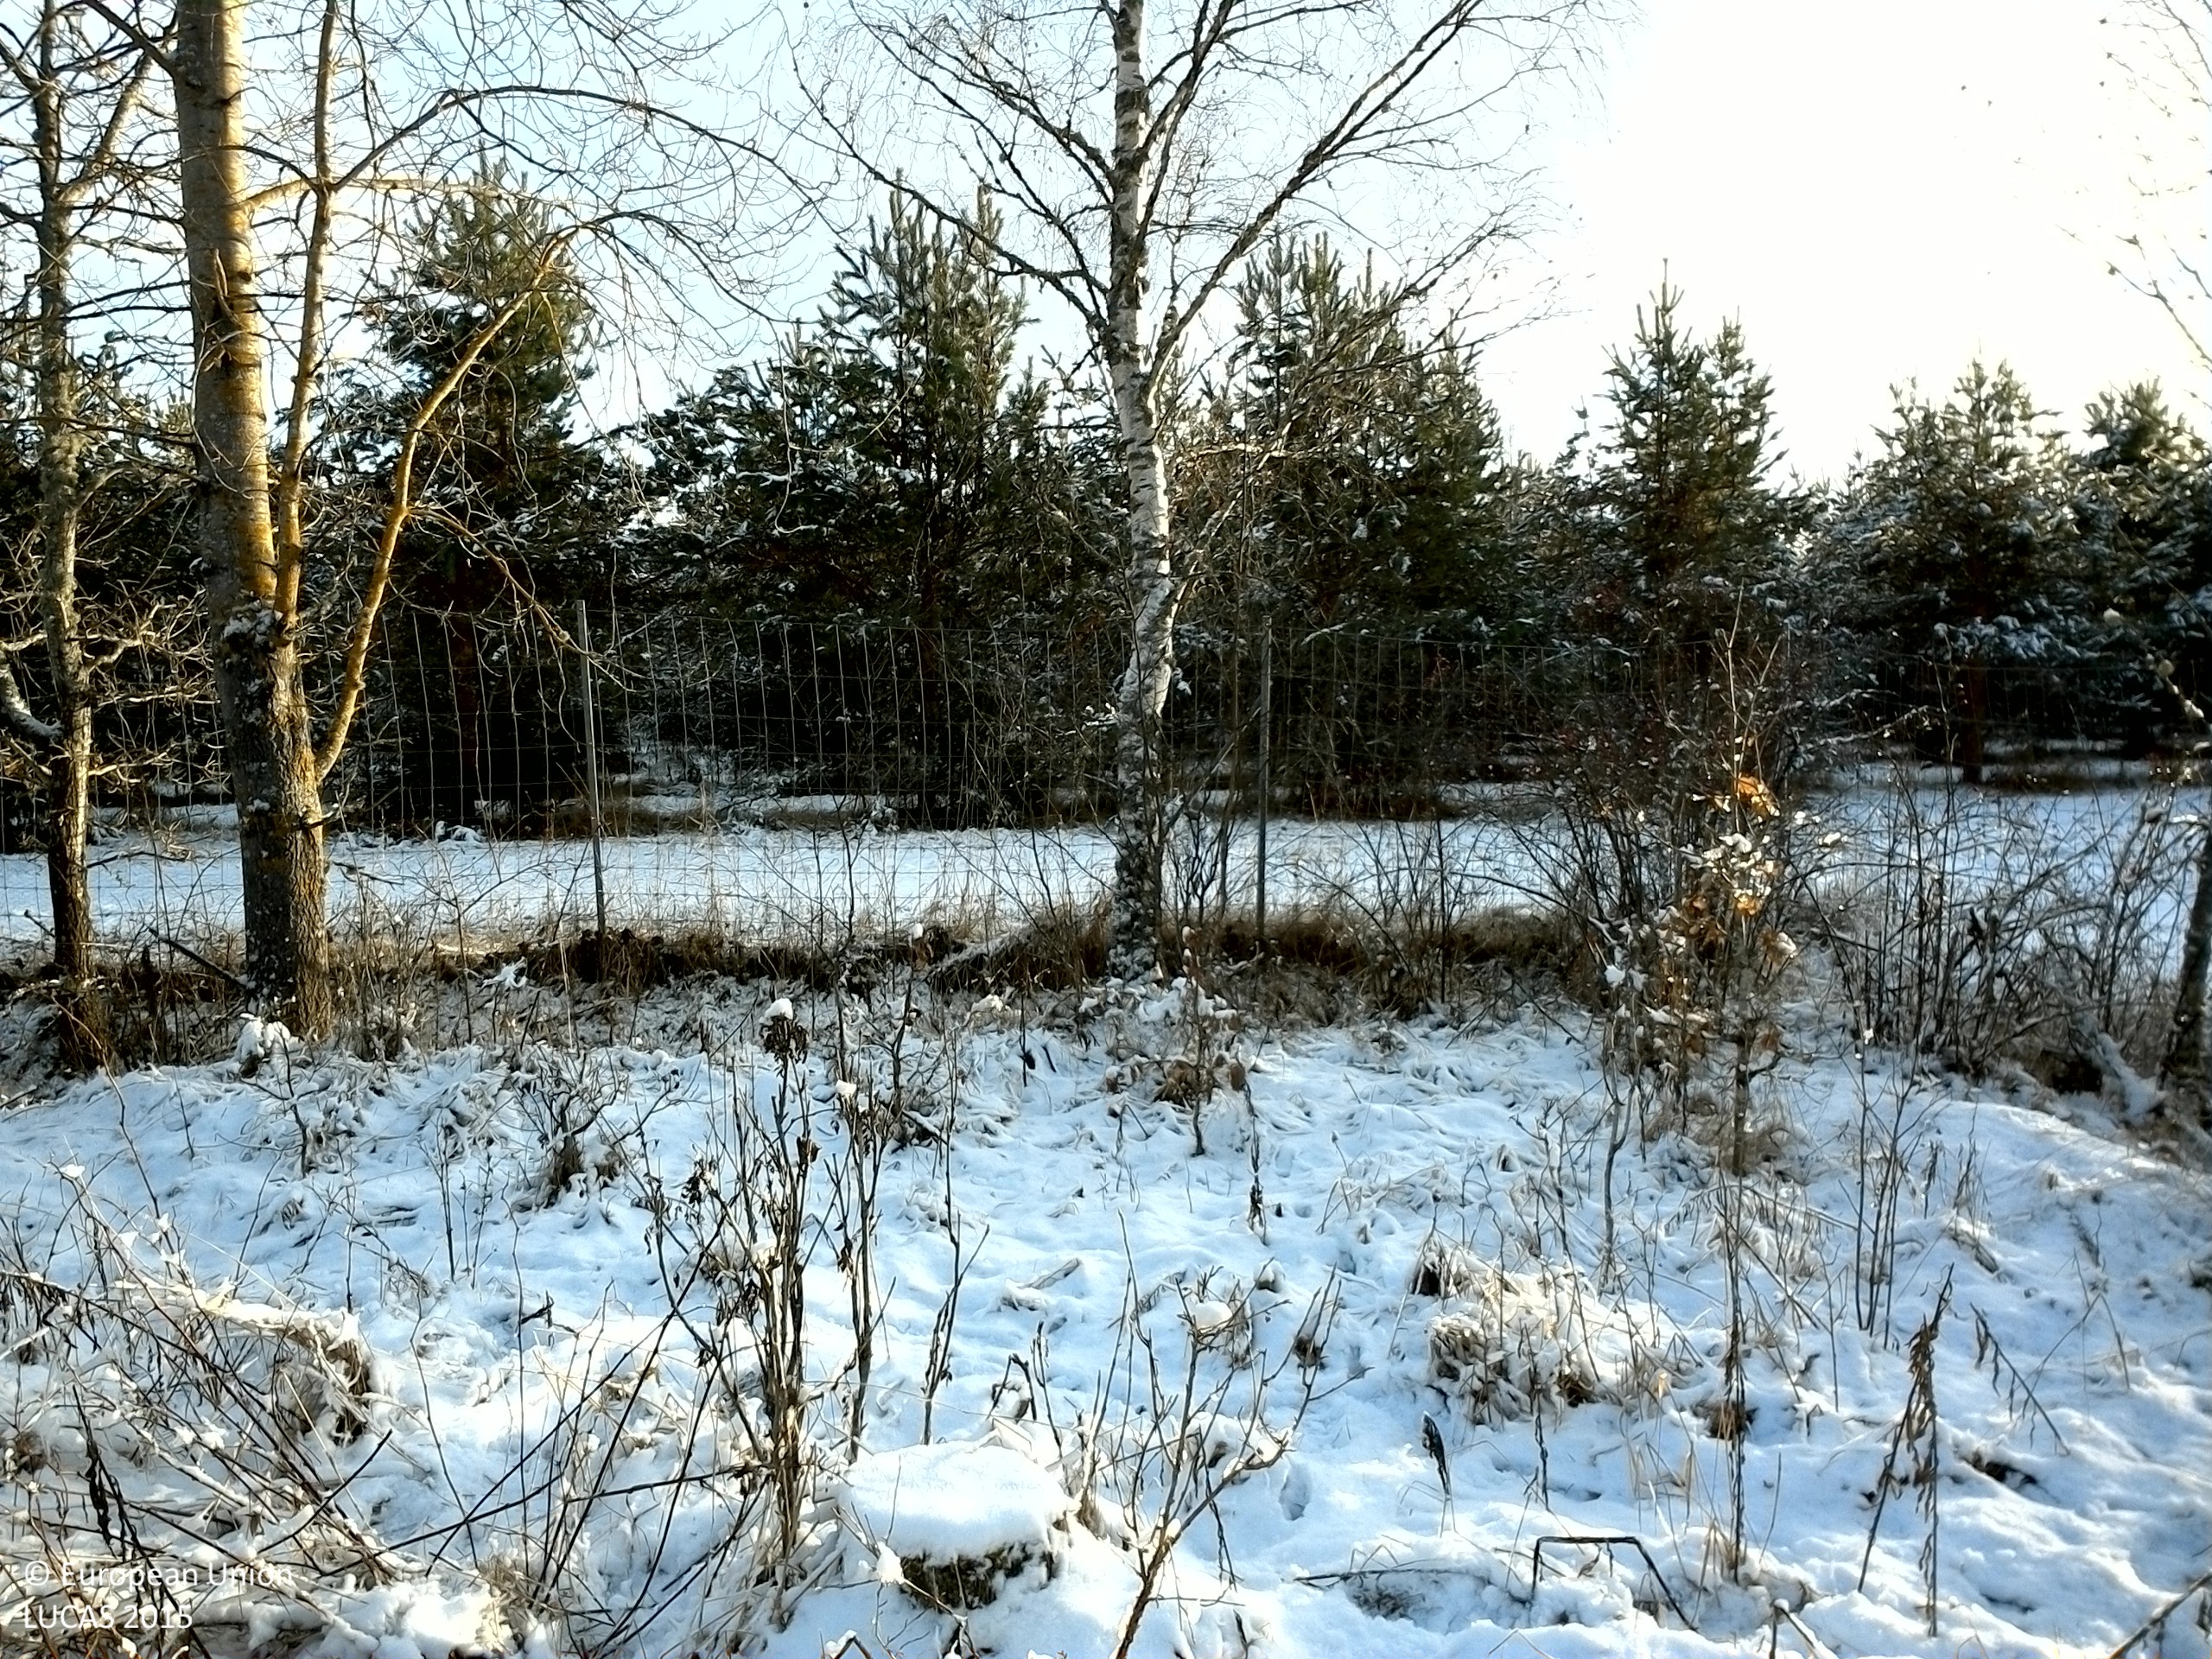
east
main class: Woodland
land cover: Spruce dominated mixed woodland
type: boreal forest
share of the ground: 50 - 75 %
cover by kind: broadleaved forest trees 40 %, shrubs 30 %, coniferous forest trees 20 %, herbaceous plants 10 %
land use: Forestry
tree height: > 5 m
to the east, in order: Spruce dominated mixed woodland; Single bushes/trees; Ditches and canals; Fences; Grassland without tree/shrub cover; Pine dominated coniferous woodland
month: December
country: SE
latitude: 59.6854
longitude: 16.5460
